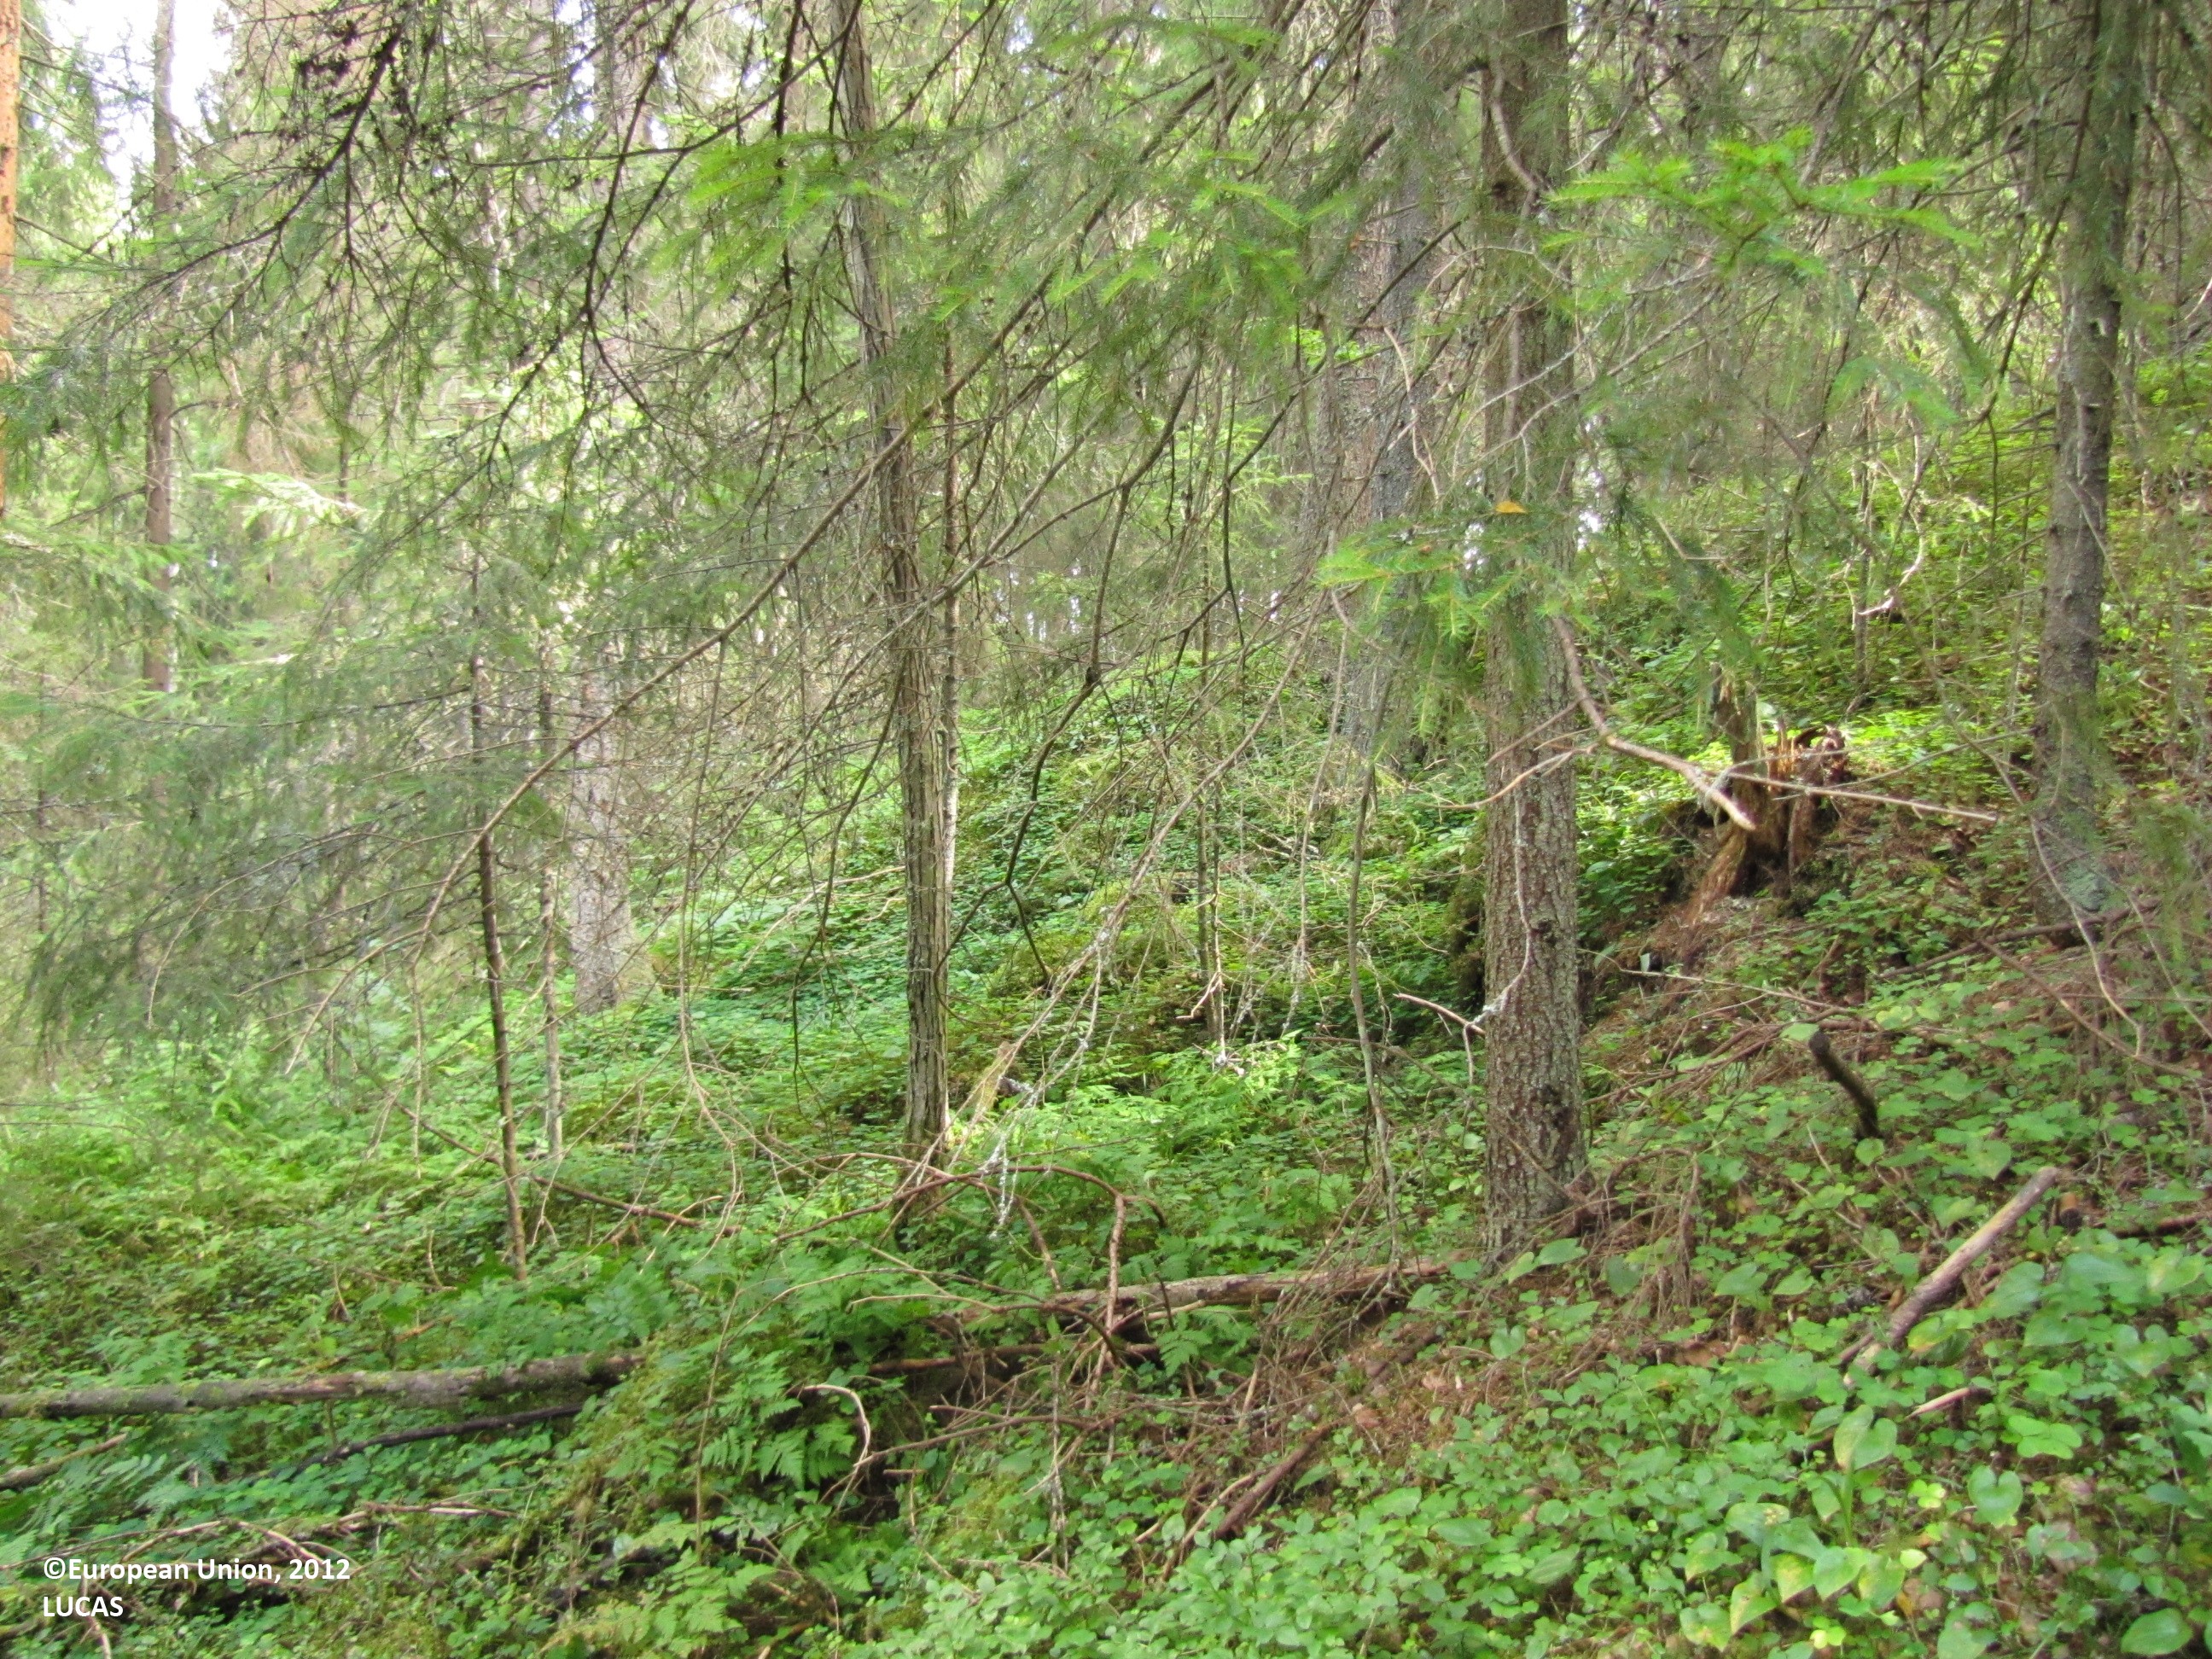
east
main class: Woodland
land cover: Spruce dominated coniferous woodland
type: boreal forest
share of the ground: 50 - 75 %
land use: Forestry
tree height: > 5 m
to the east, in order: Spruce dominated coniferous woodland
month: August
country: FI
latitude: 61.7390
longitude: 23.1537
